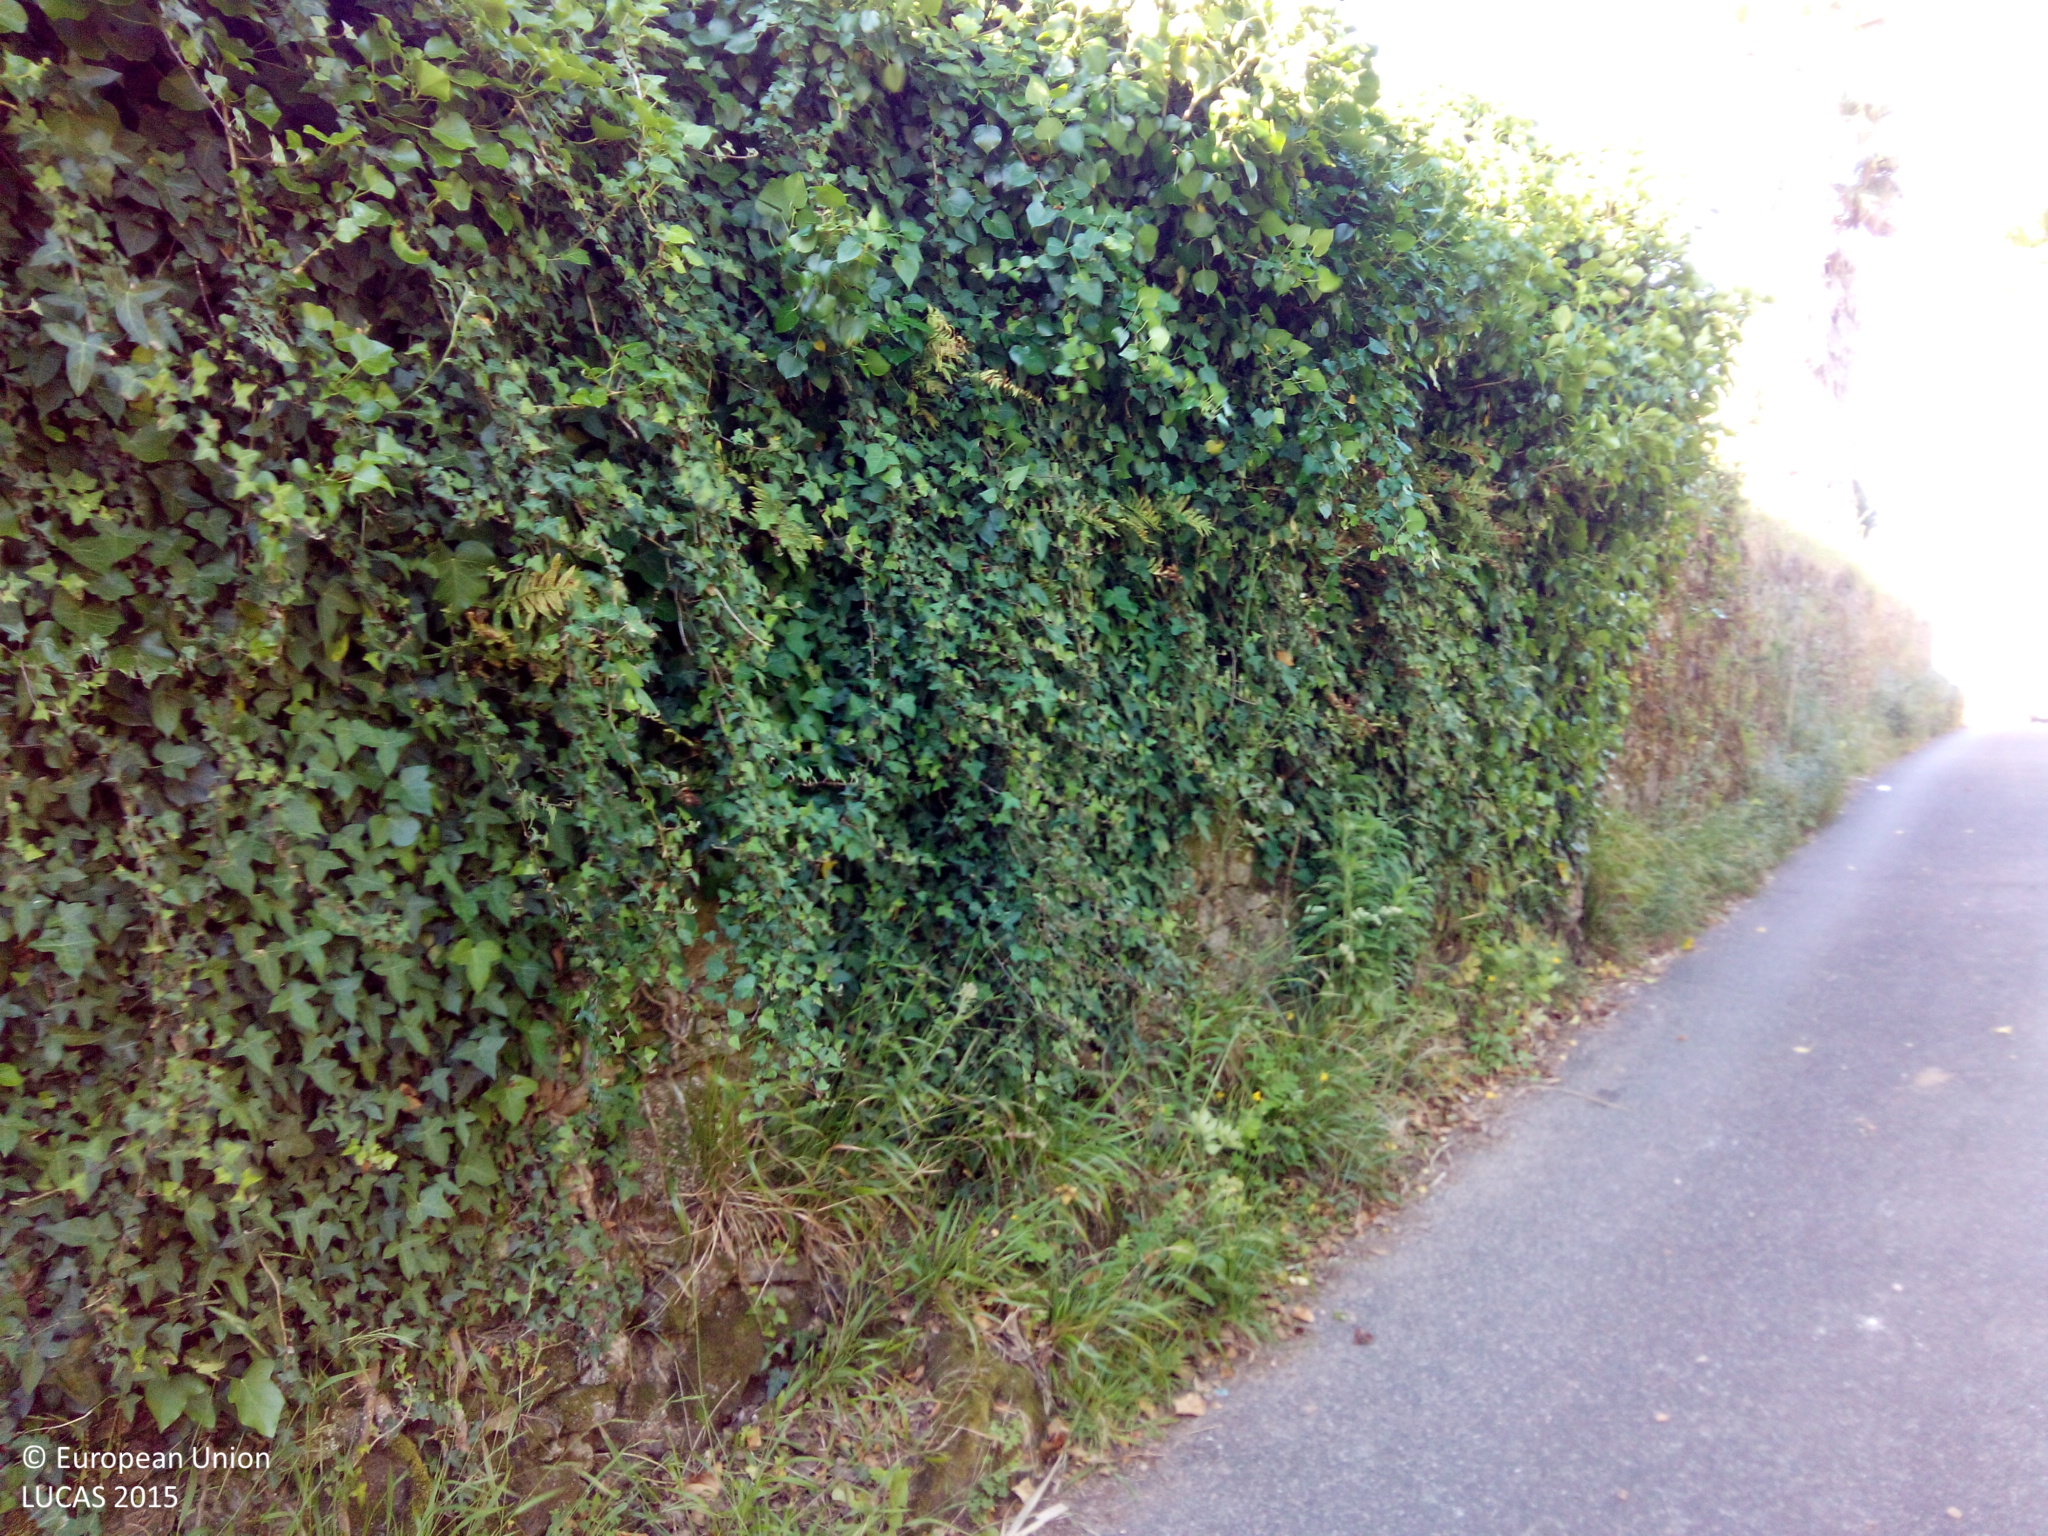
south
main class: Cropland
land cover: Cherry fruit
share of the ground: 25 - 50 %
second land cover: Spontaneously vegetated surfaces
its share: > 75 %
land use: Agriculture (excluding fallow land and kitchen gardens)
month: May
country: ES
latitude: 42.5819
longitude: -8.9634
